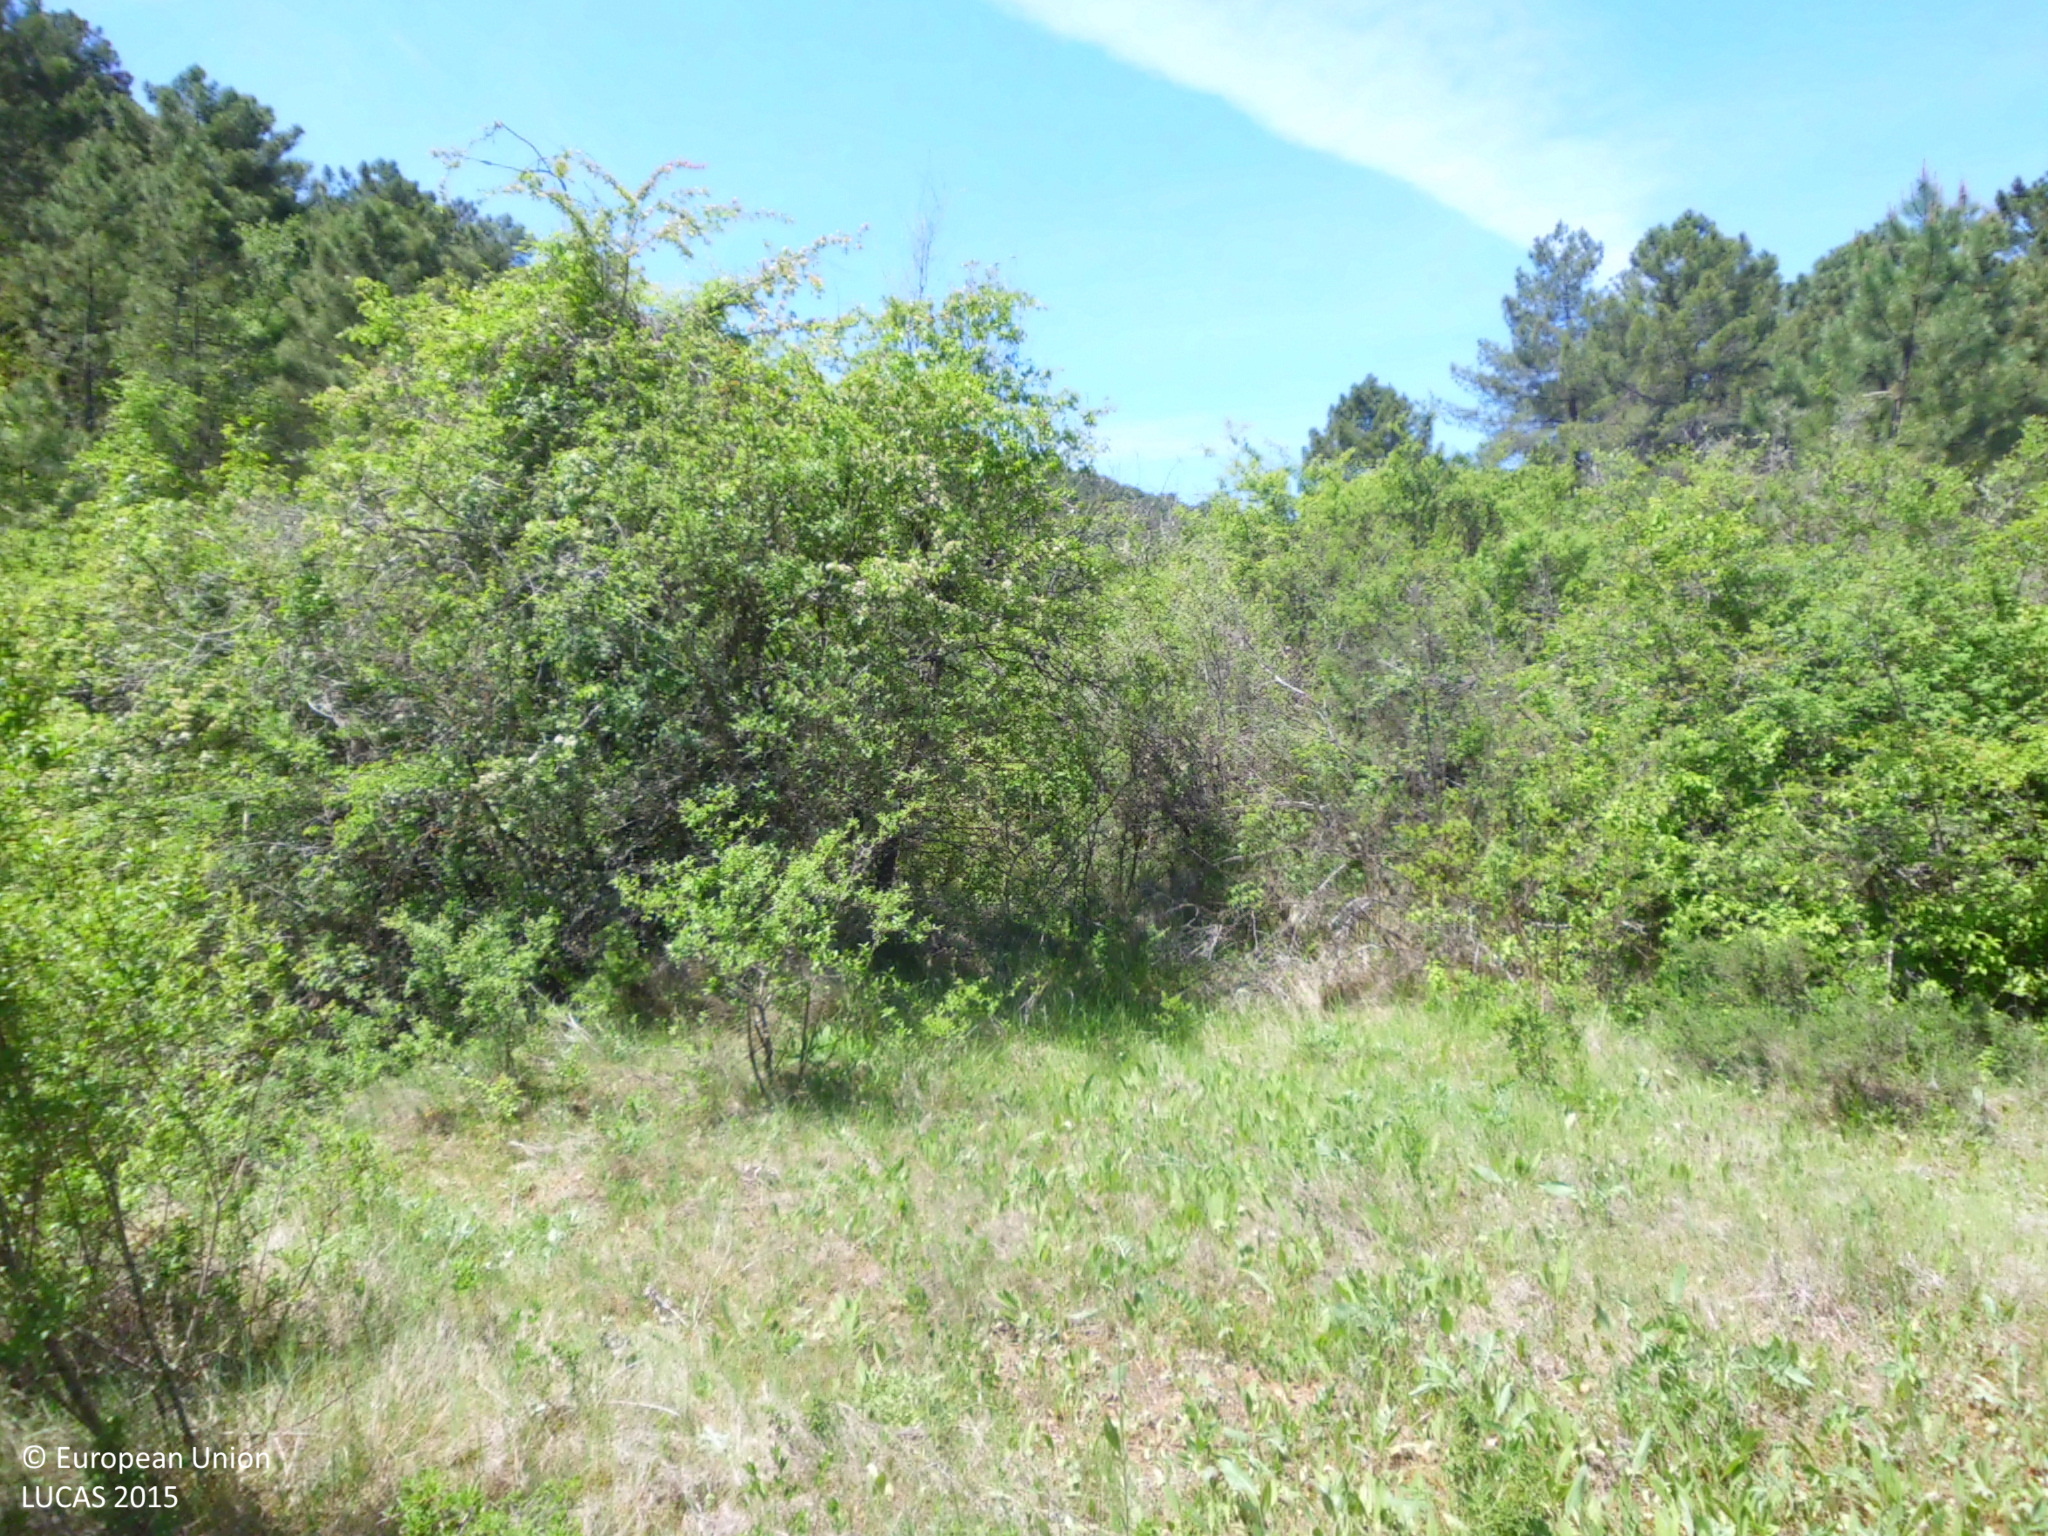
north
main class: Woodland
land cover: Pine dominated coniferous woodland
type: coniferous forest of the mediterranean region
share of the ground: > 75 %
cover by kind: coniferous forest trees 75 %, herbaceous plants 15 %, shrubs 10 %
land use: Semi-natural and natural areas not in use
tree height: > 5 m
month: May
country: ES
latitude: 42.7348
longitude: -3.4850
